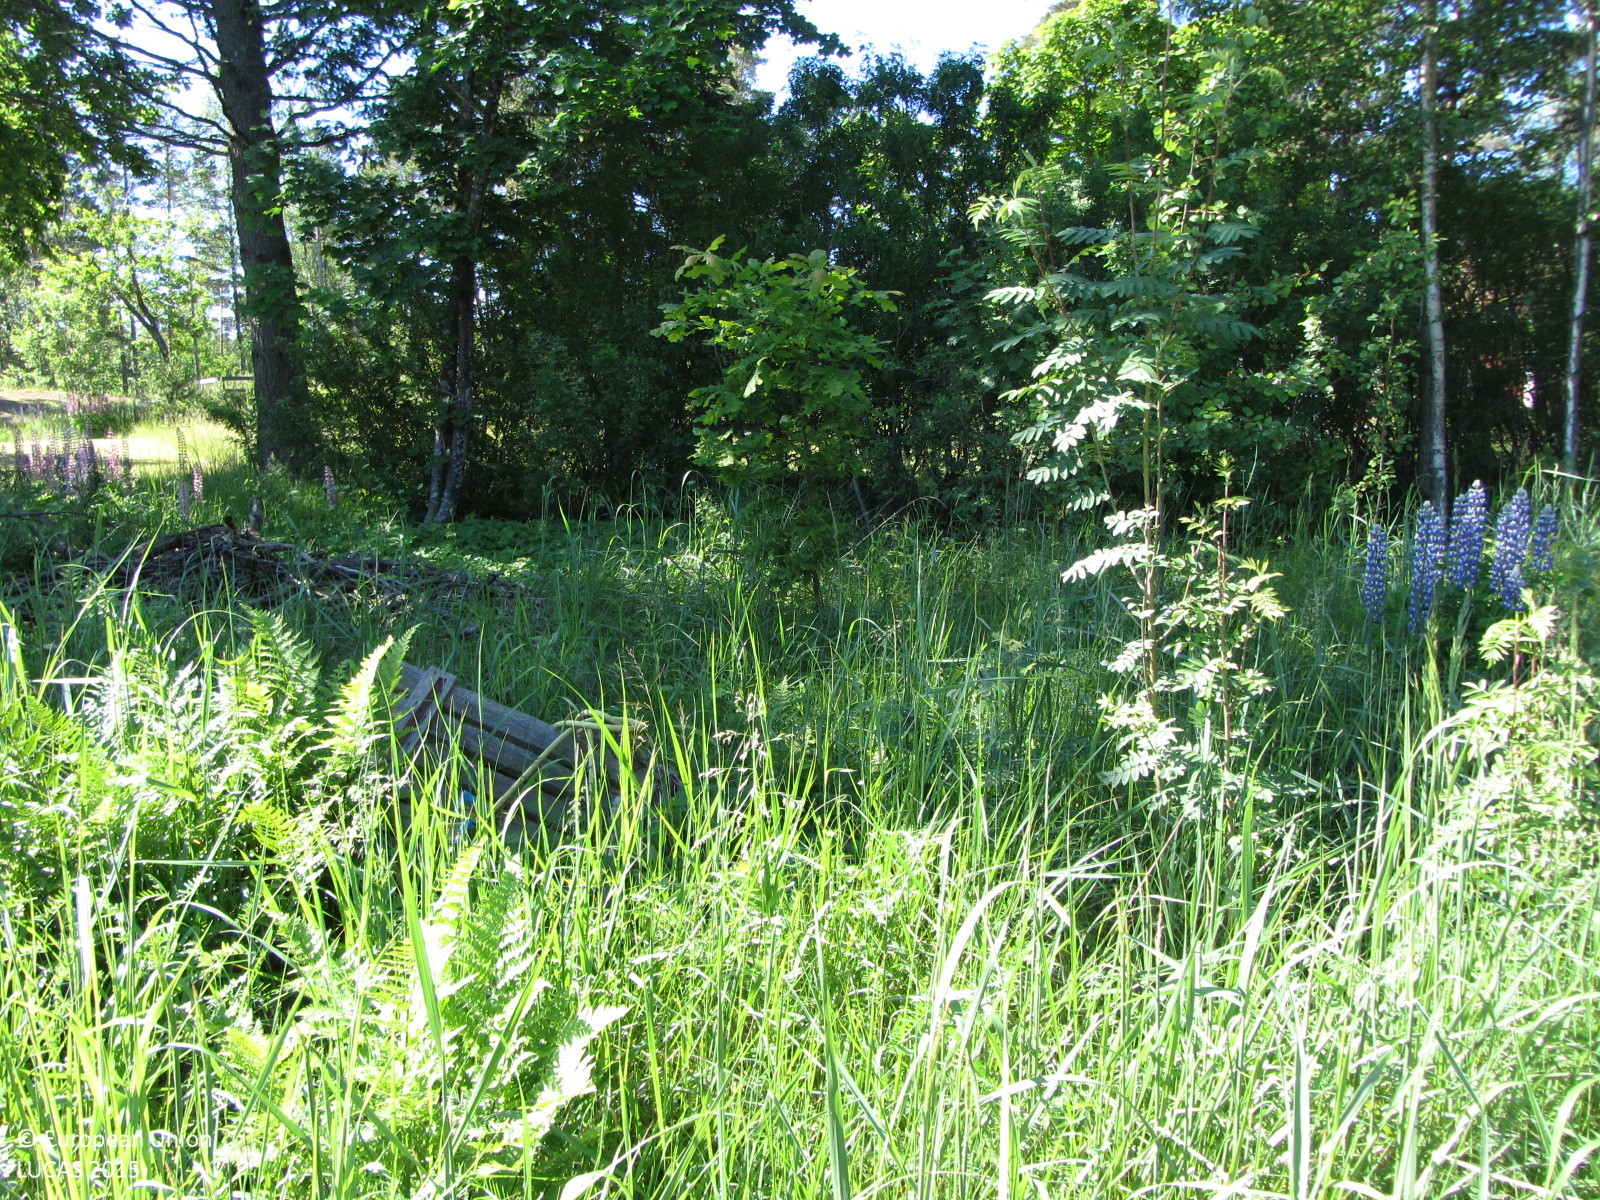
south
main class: Grassland
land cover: Grassland with sparse tree/shrub cover
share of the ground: > 75 %
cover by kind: herbaceous plants 90 %, broadleaved forest trees 5 %, shrubs 5 %
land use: Residential
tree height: < 5 m
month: July
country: FI
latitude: 59.8412
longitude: 23.0926
